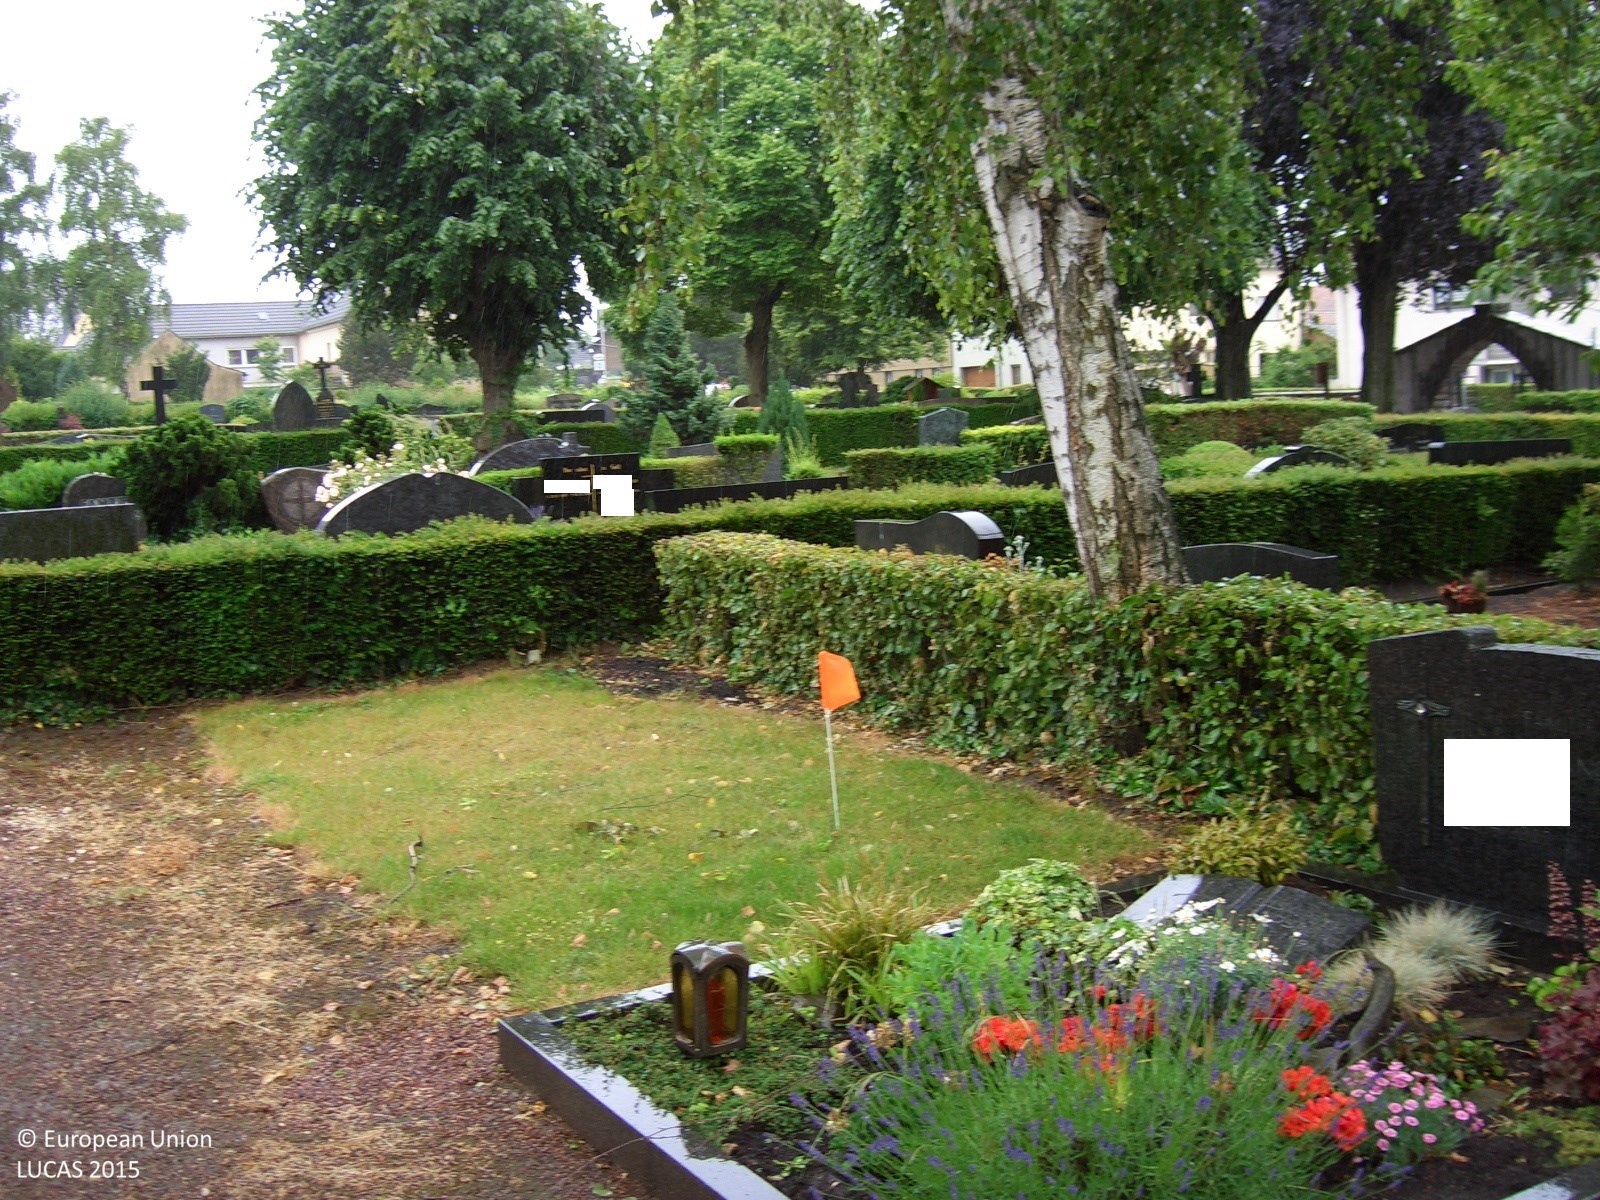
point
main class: Woodland
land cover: Broadleaved woodland
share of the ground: 25 - 50 %
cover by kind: broadleaved forest trees 50 %, herbaceous plants 30 %, shrubs 20 %
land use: Community services
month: June
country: DE
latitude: 50.7568
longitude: 7.0090
